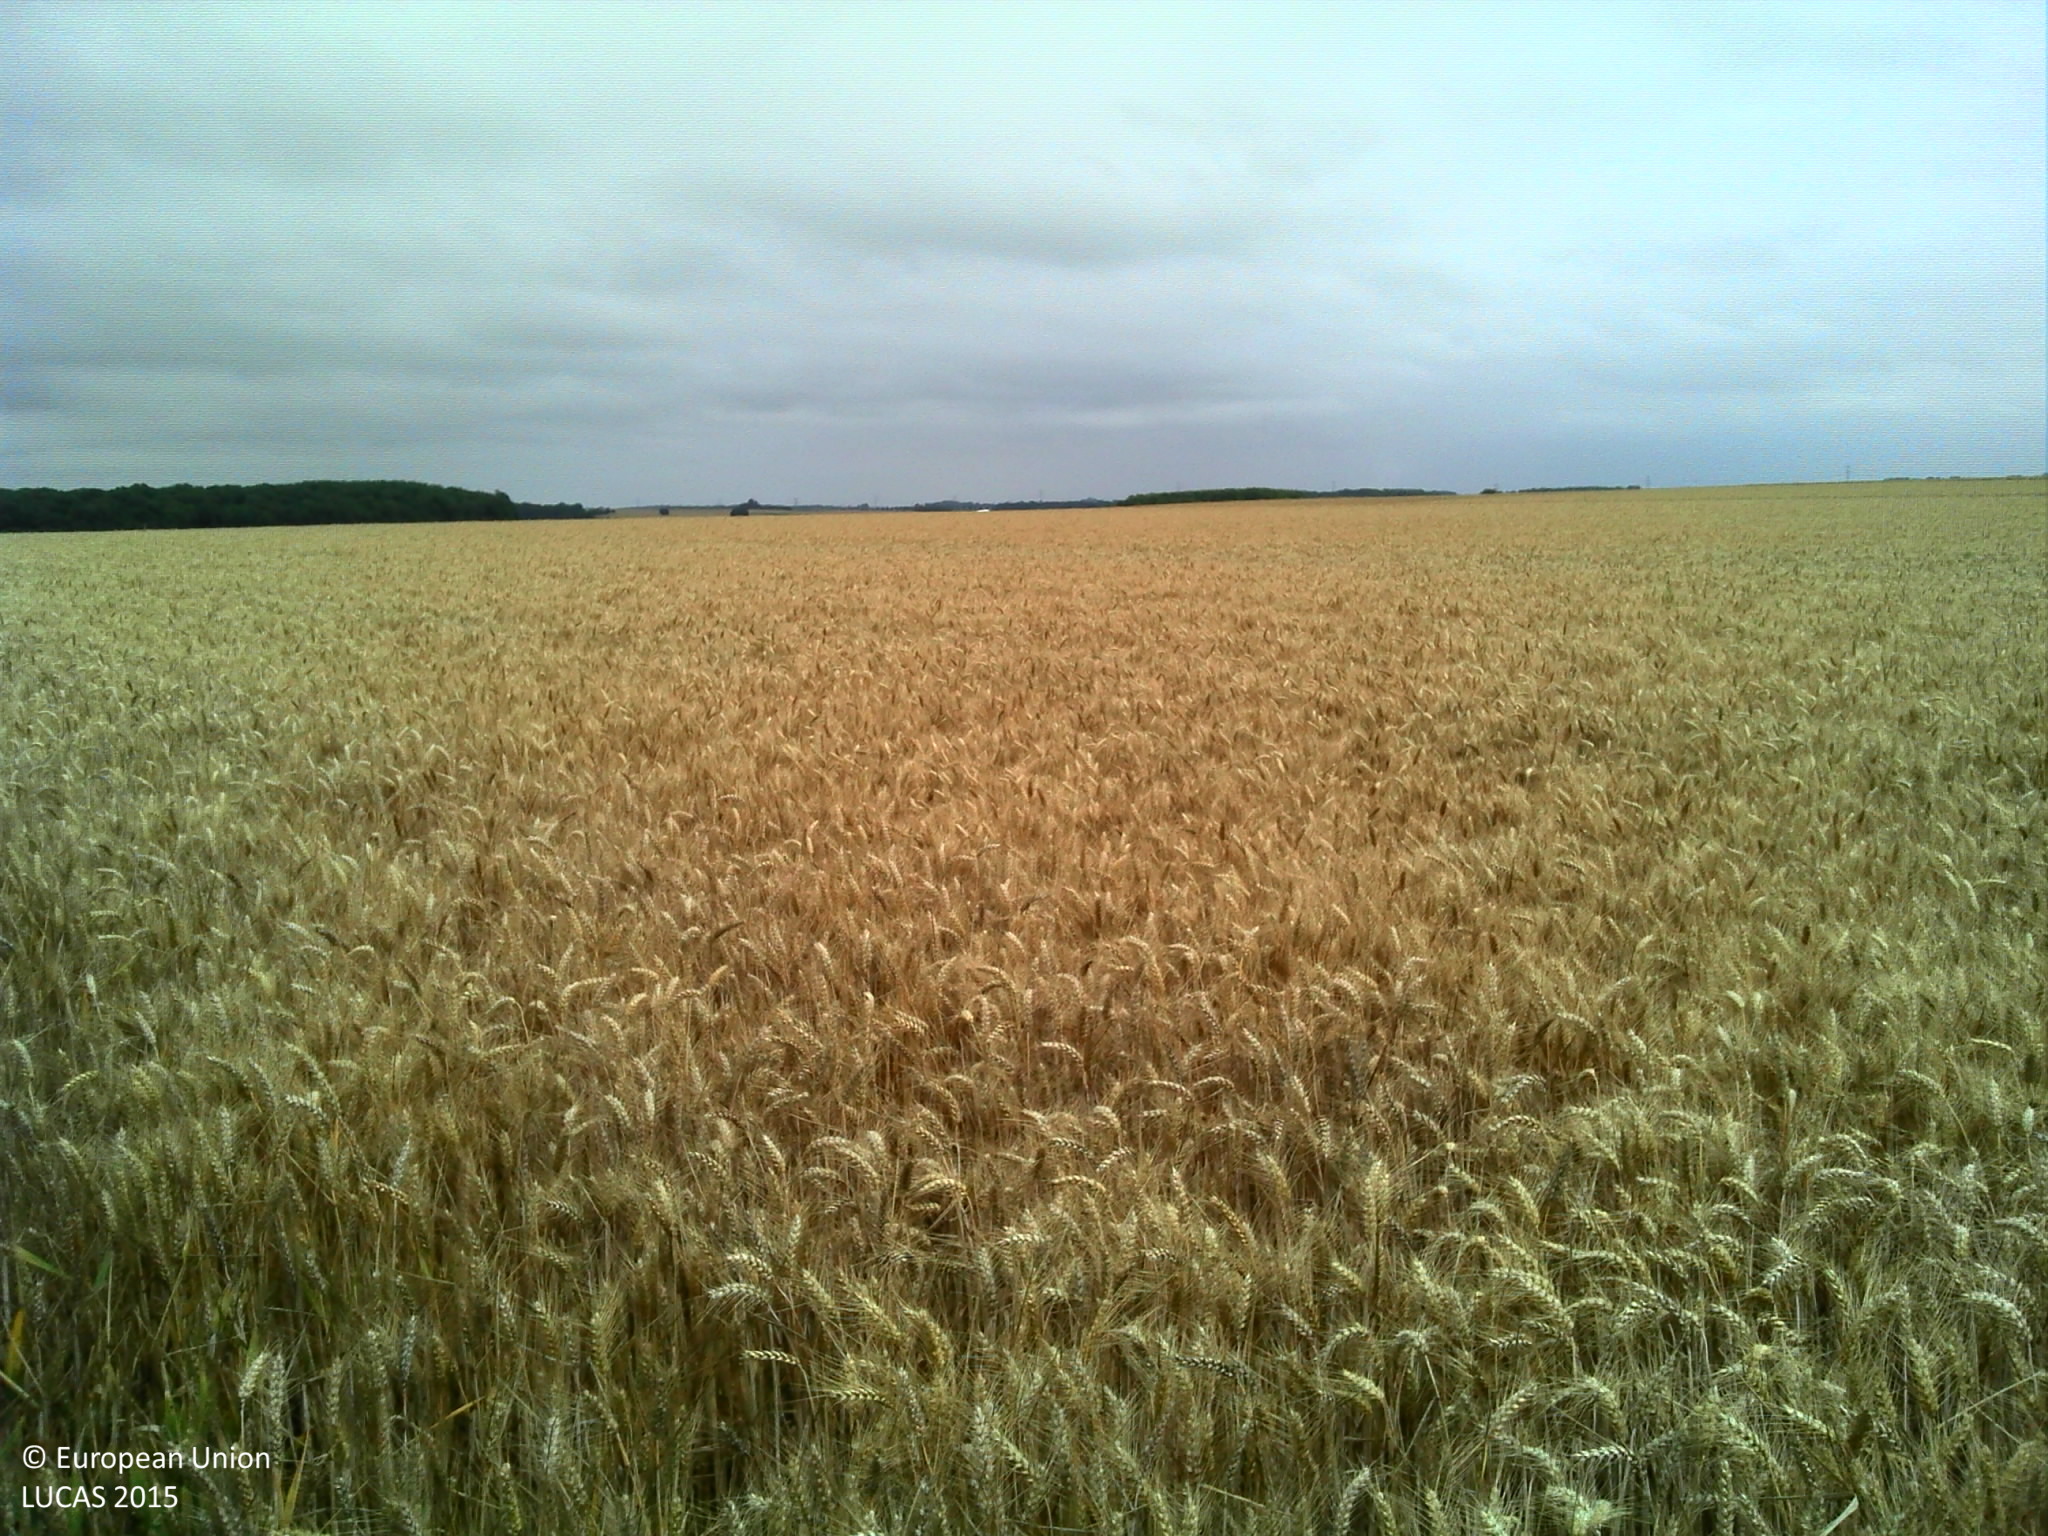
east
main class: Cropland
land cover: Maize
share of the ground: > 75 %
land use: Agriculture (excluding fallow land and kitchen gardens)
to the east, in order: Maize; Common wheat
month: July
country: FR
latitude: 50.1198
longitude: 2.5332
